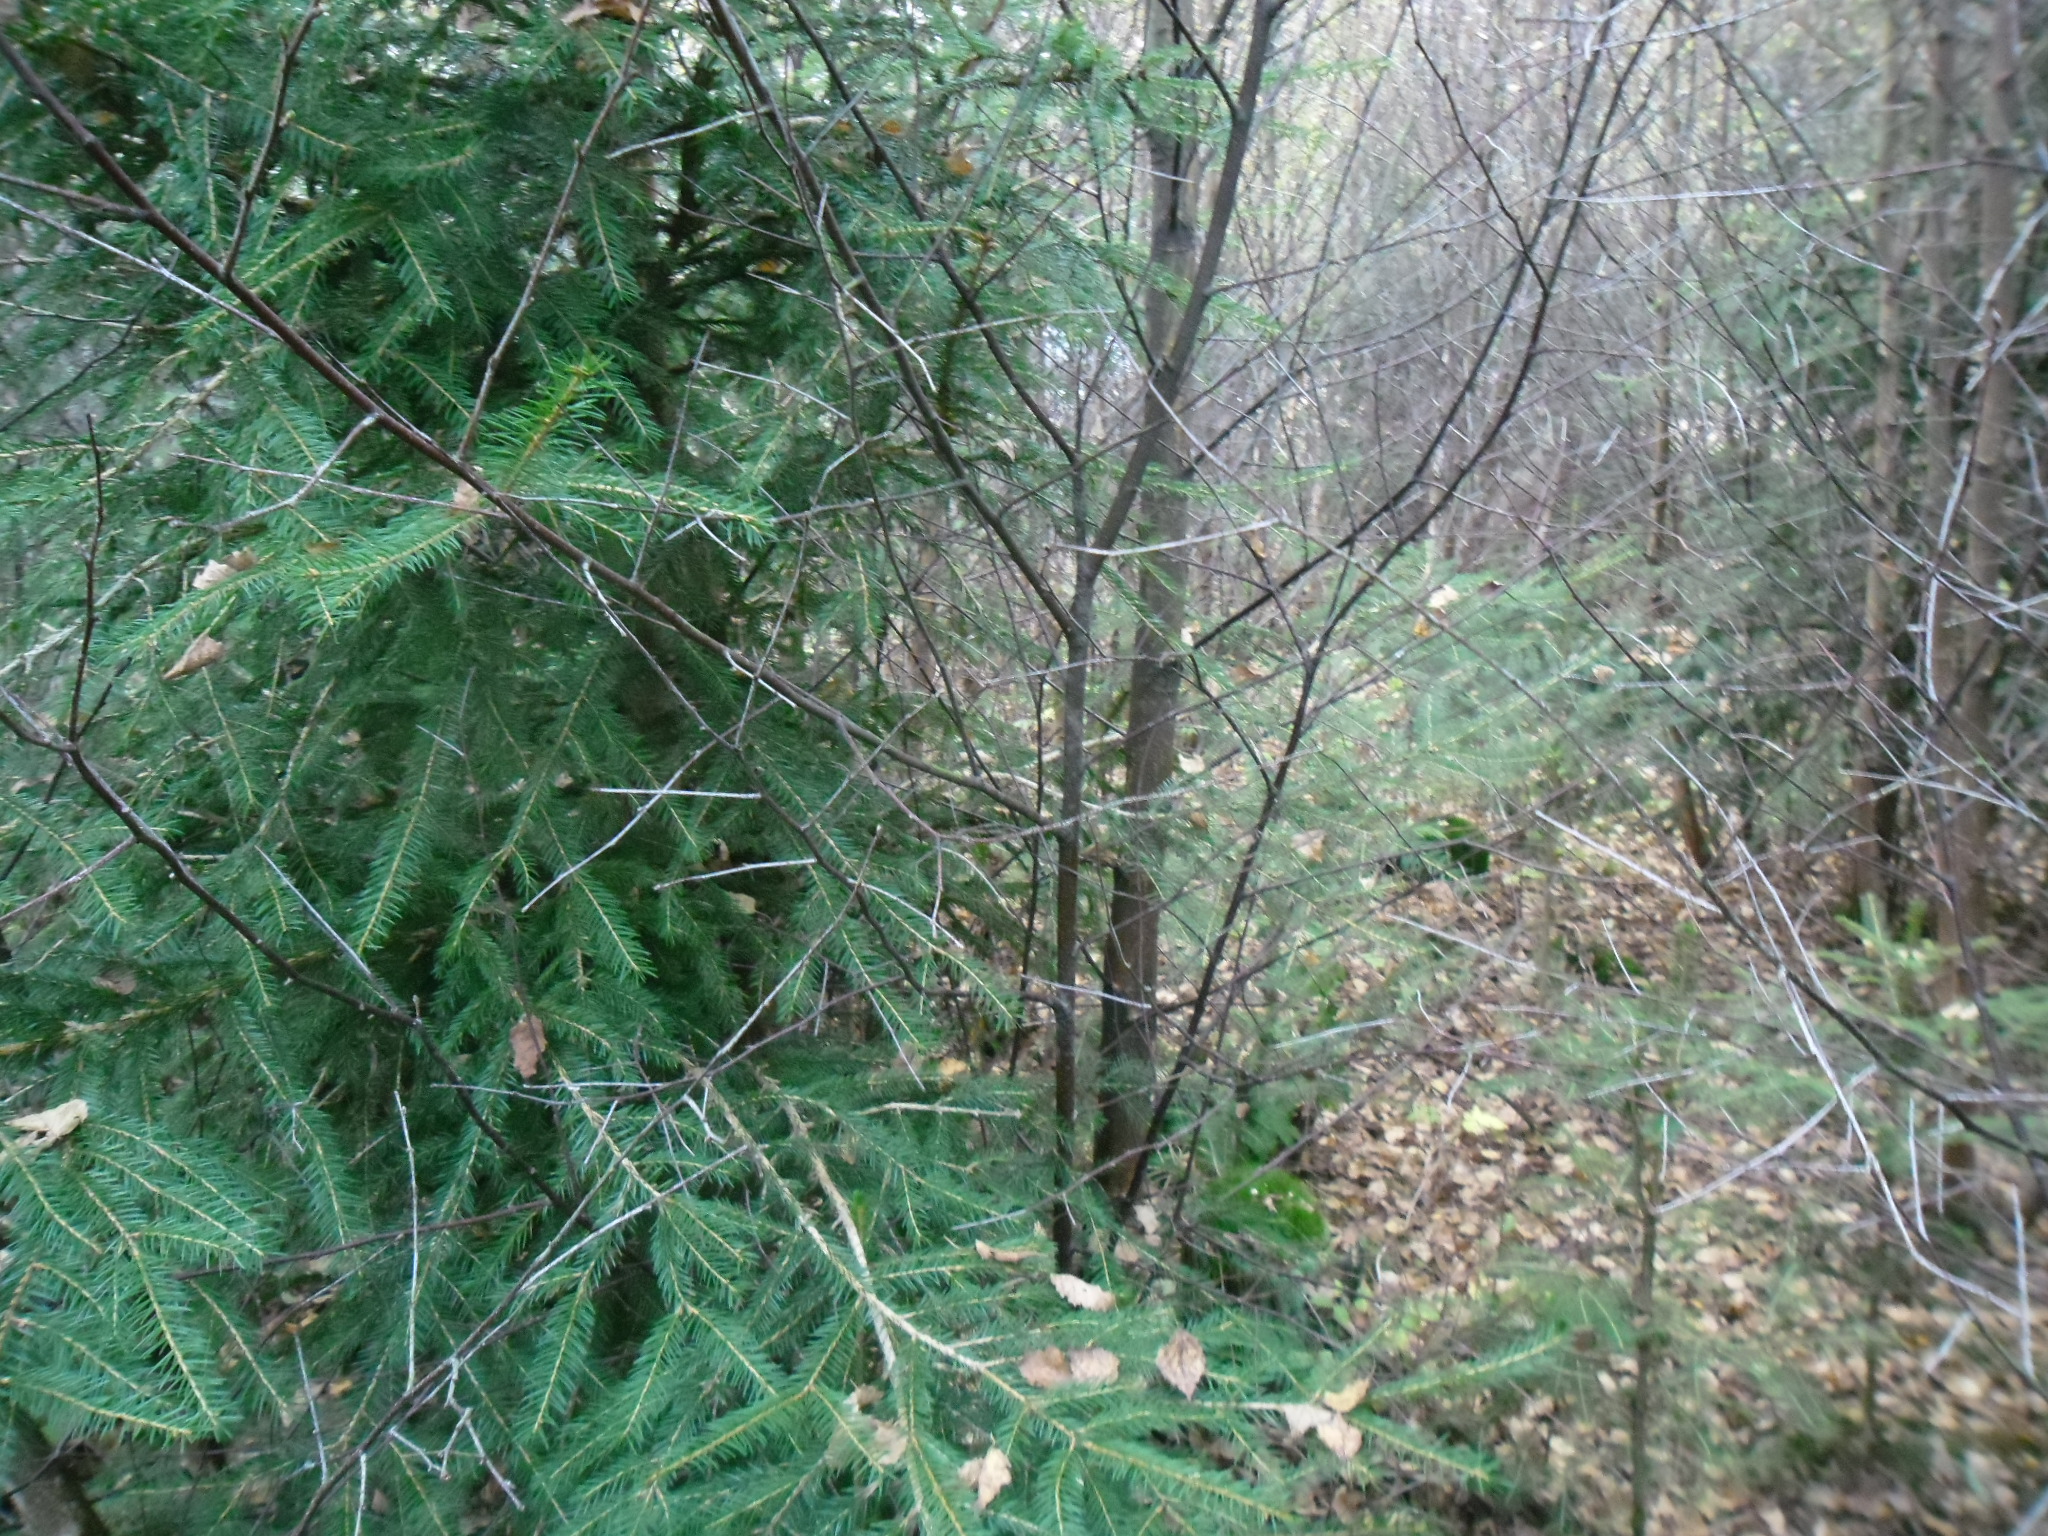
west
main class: Woodland
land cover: Spruce dominated mixed woodland
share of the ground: > 75 %
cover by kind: coniferous forest trees 65 %, broadleaved forest trees 35 %
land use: Forestry
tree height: < 5 m
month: October
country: SE
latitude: 56.6359
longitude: 13.1109
